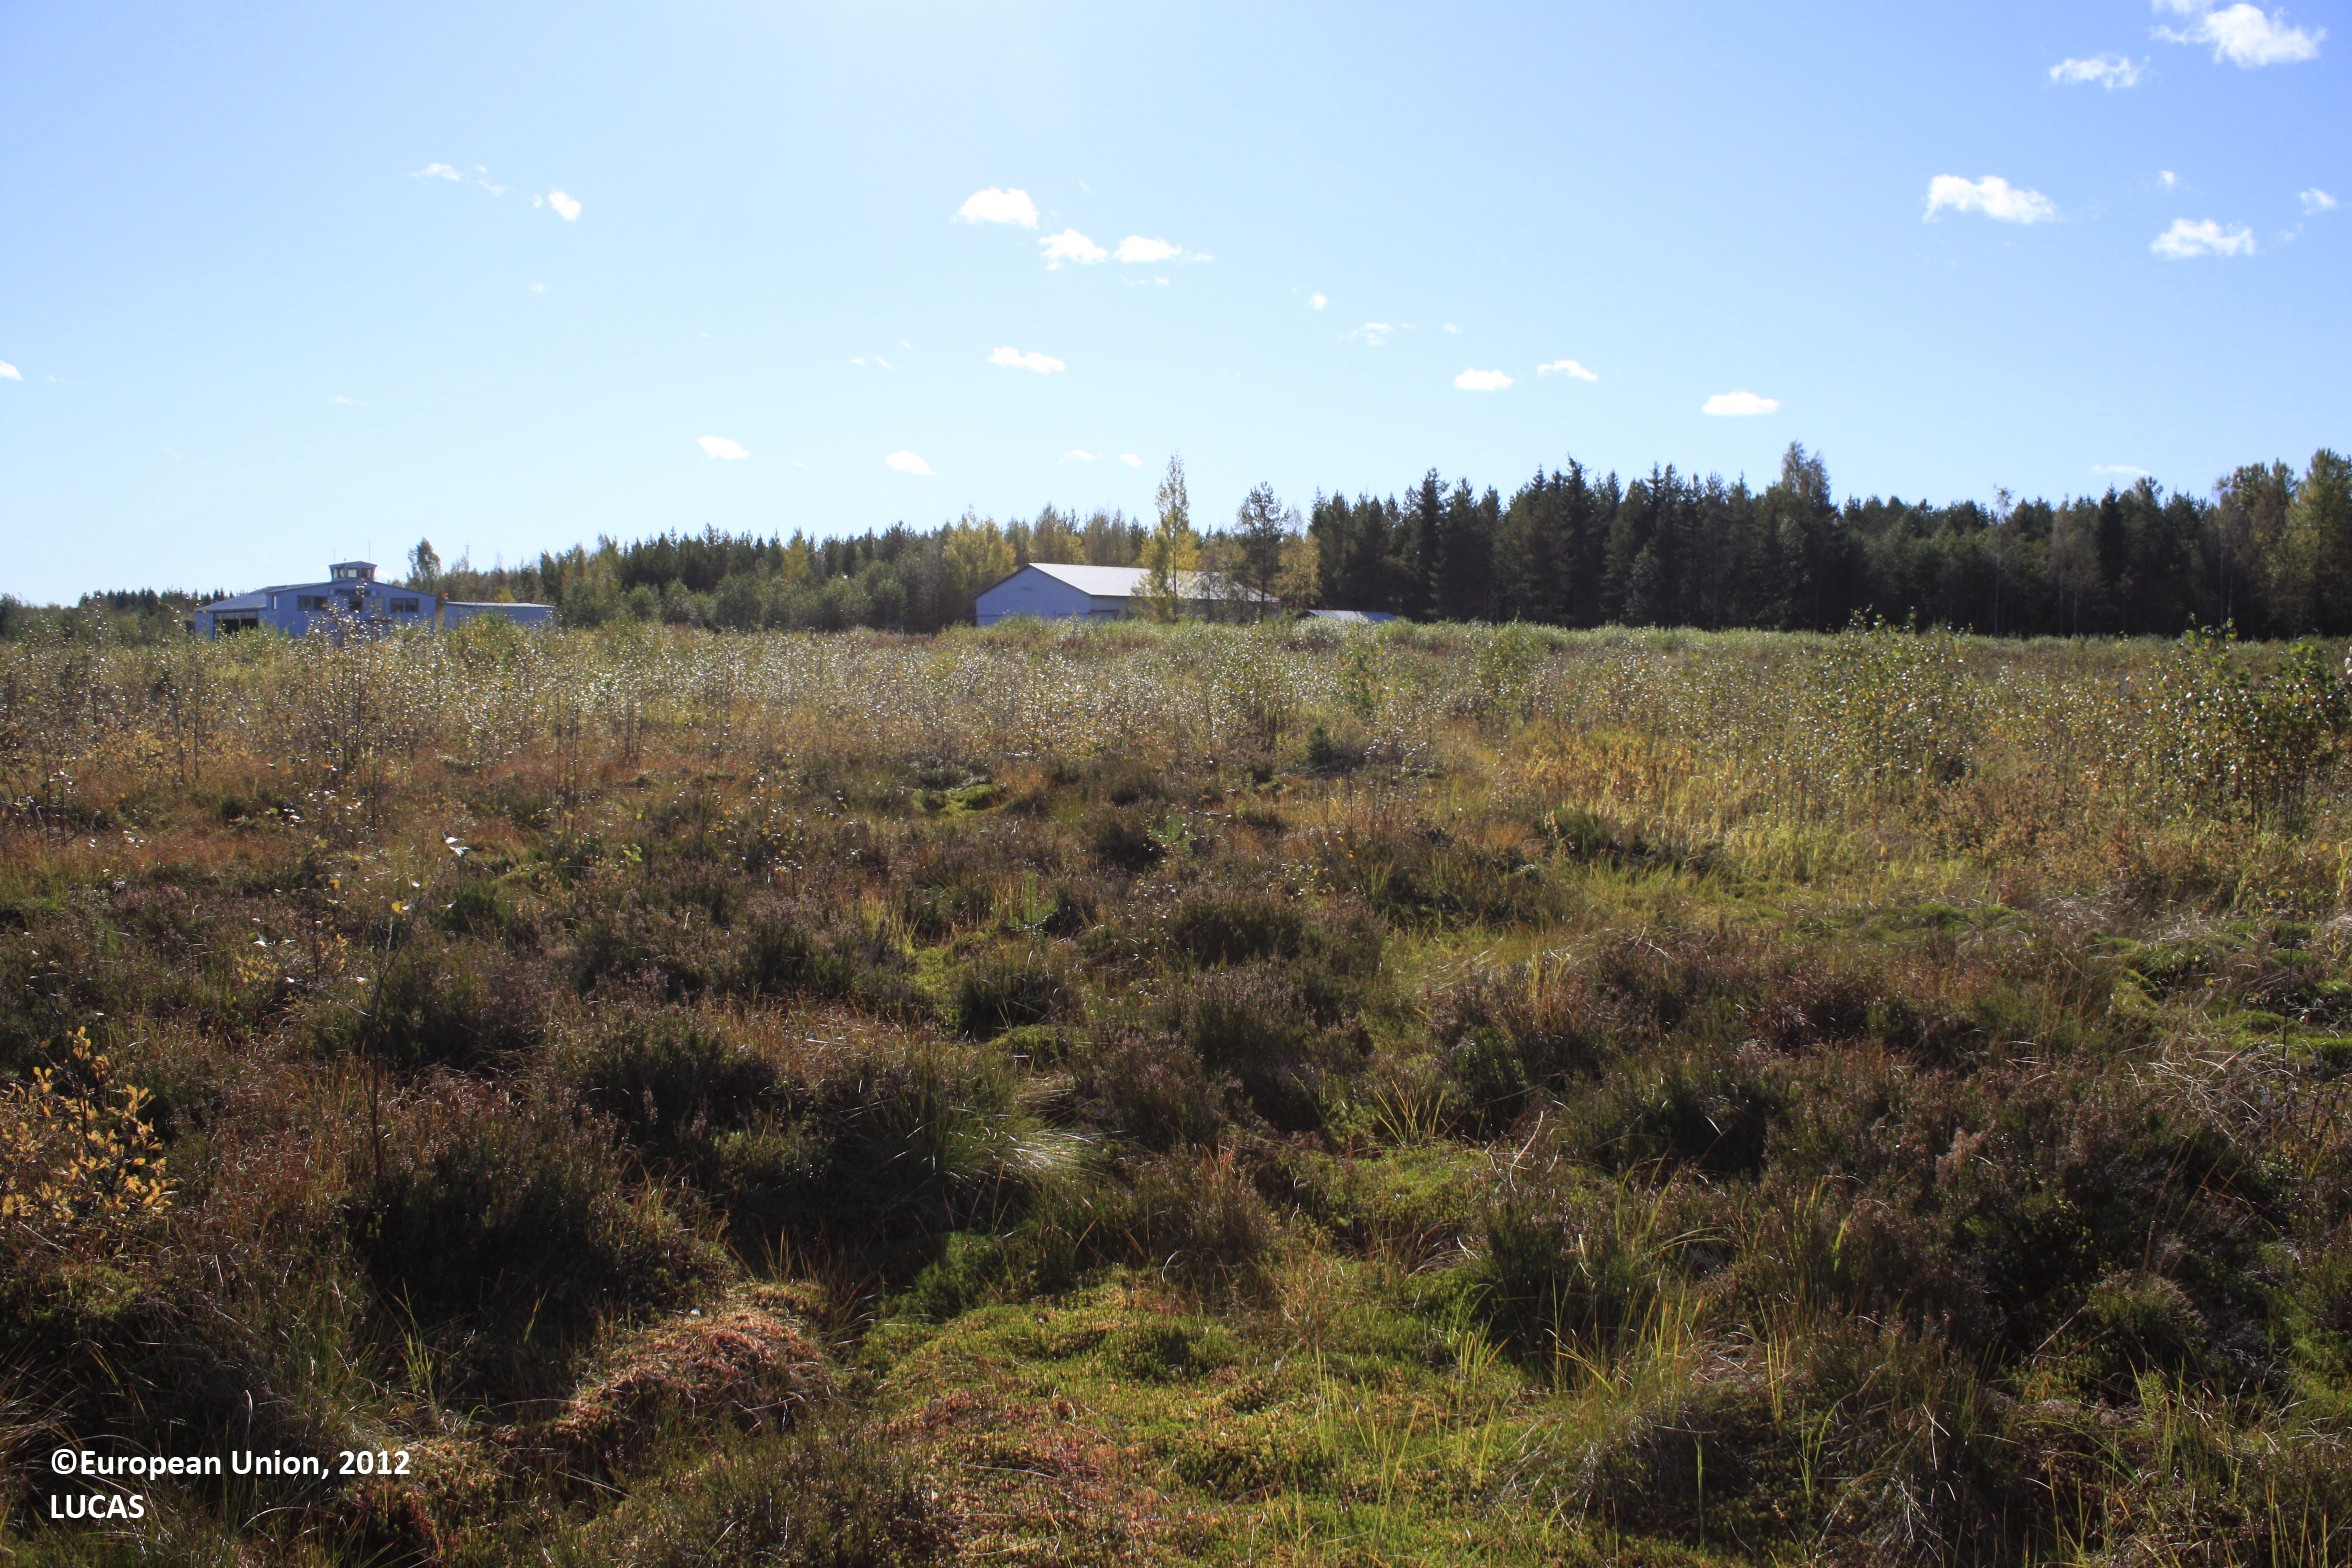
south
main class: Grassland
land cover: Grassland without tree/shrub cover
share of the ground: > 75 %
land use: Air transport
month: September
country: FI
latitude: 63.7339
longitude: 25.9271
